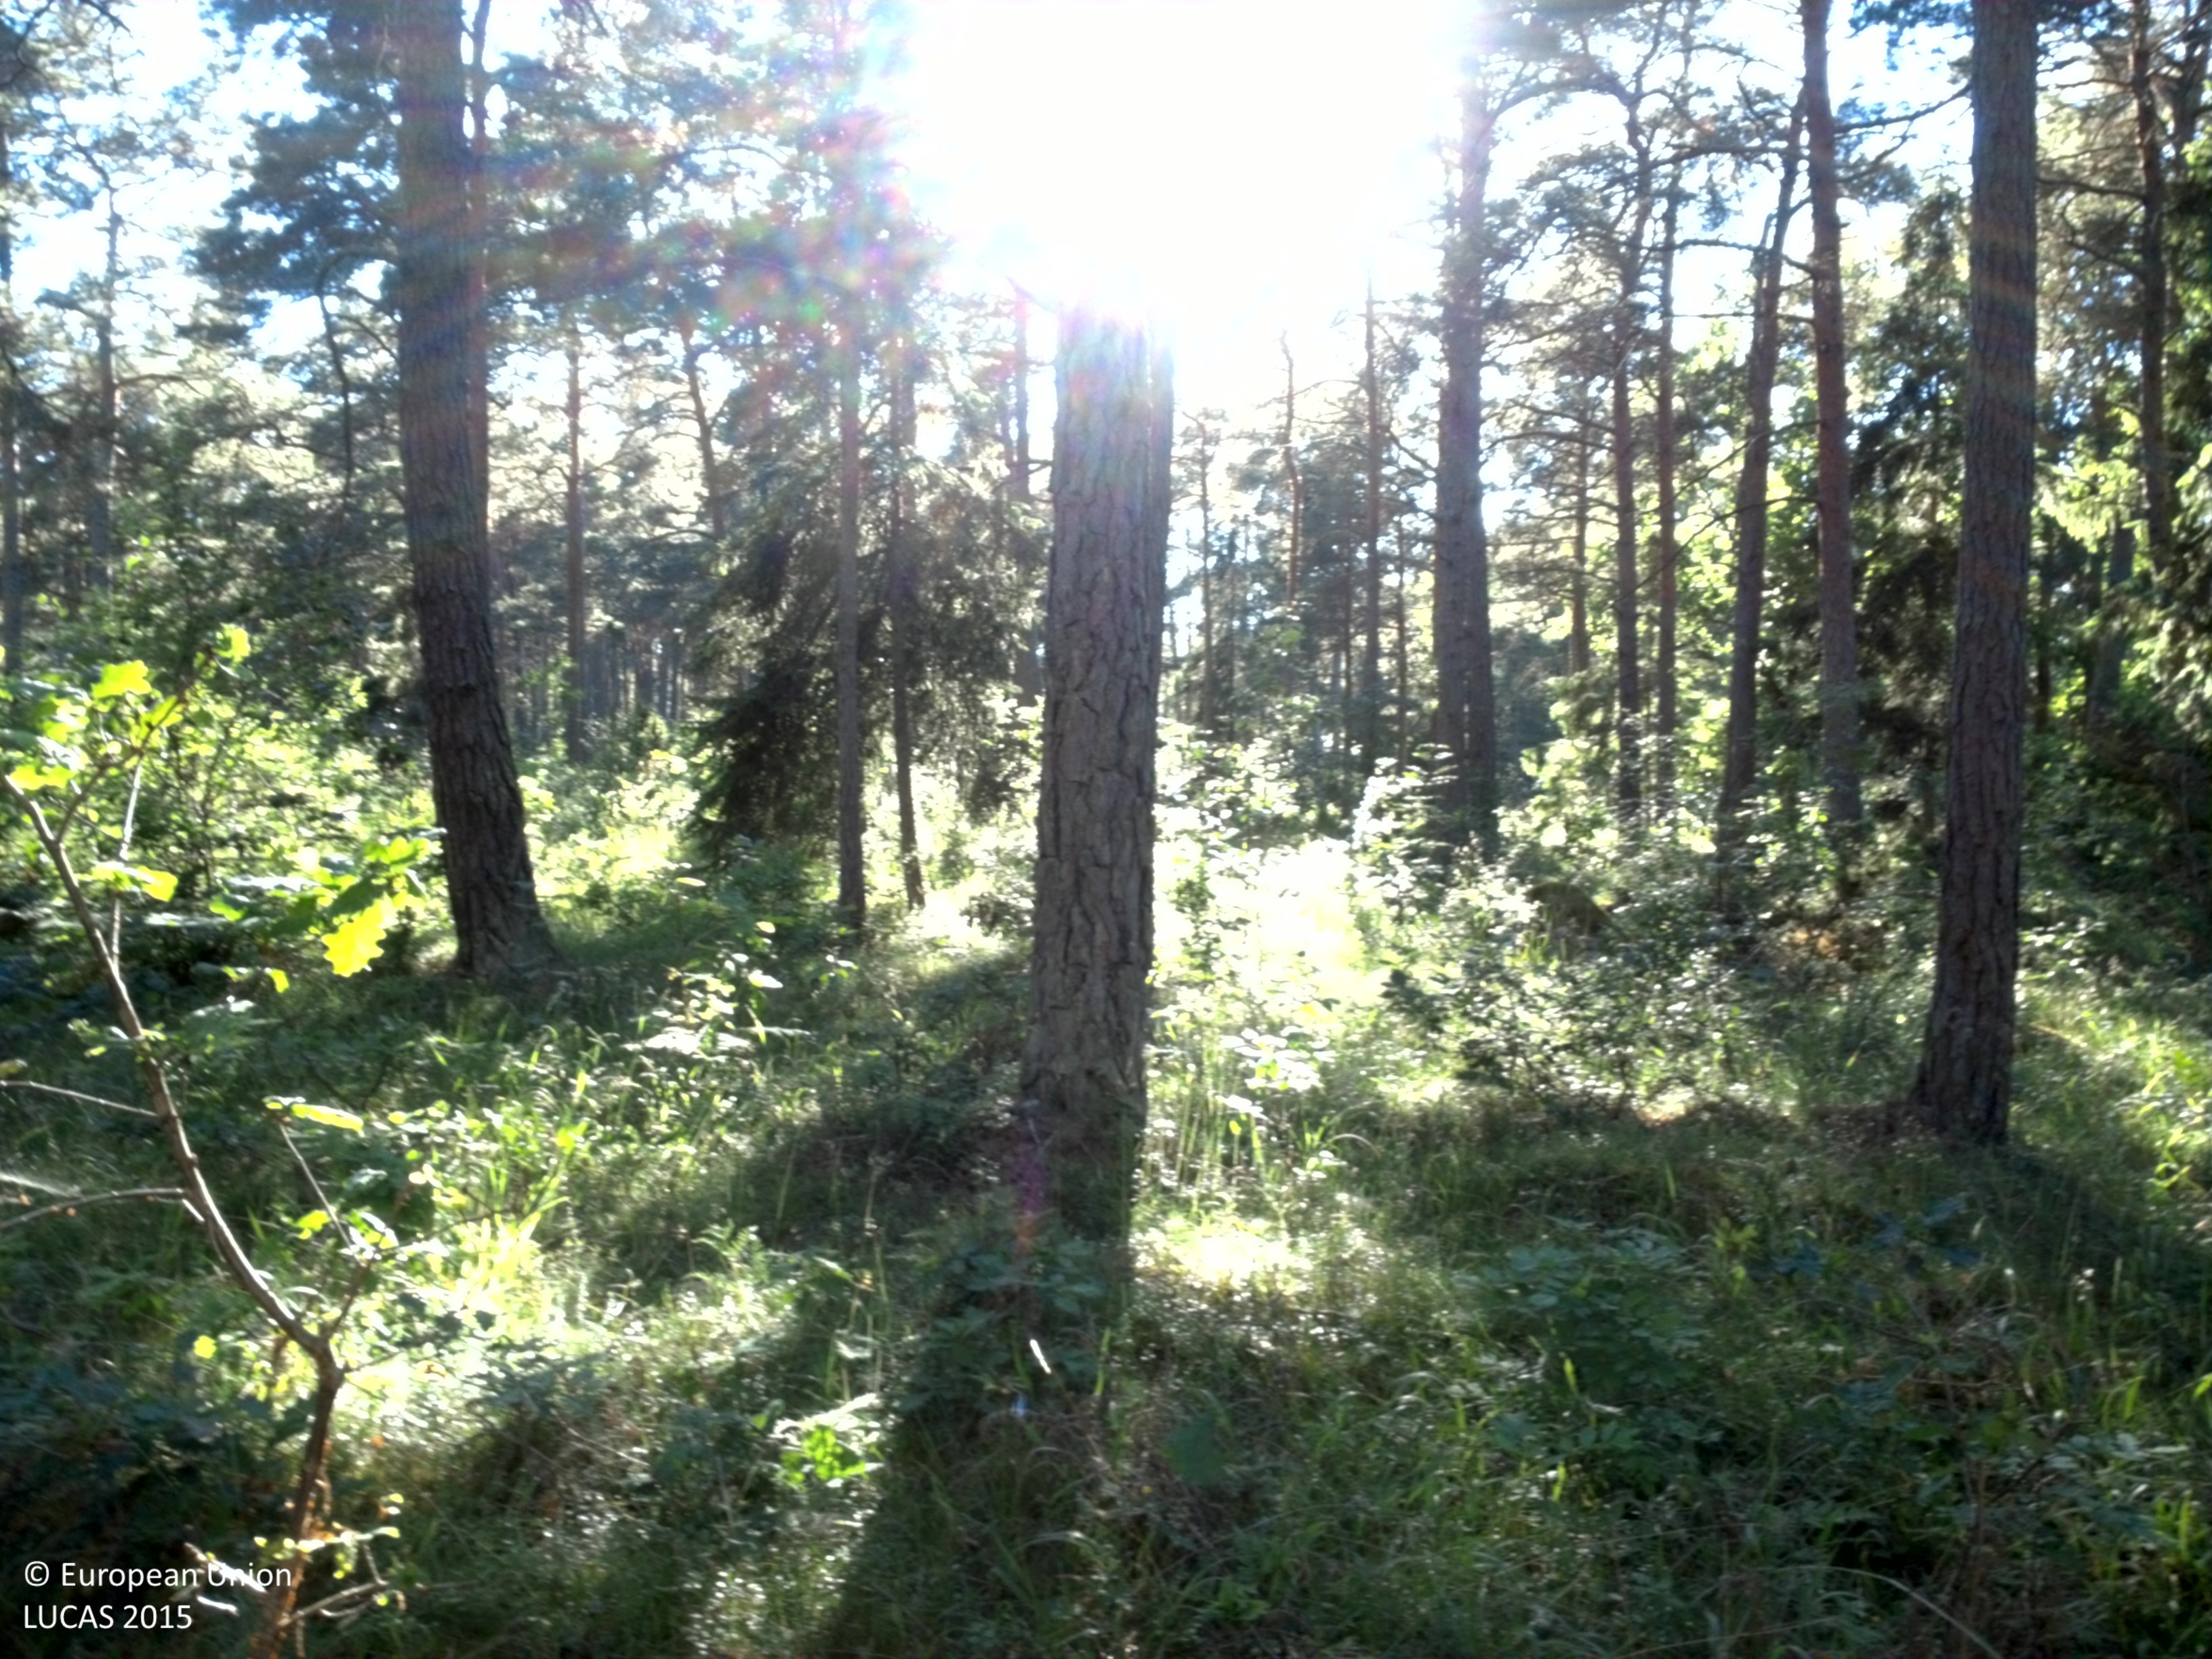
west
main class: Woodland
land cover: Pine dominated coniferous woodland
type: hemiboreal forest and nemoral coniferous forest and mixed broadleaved-coniferous forest
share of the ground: > 75 %
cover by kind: coniferous forest trees 80 %, herbaceous plants 15 %, broadleaved forest trees 5 %
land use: Forestry
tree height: > 5 m
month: July
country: SE
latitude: 57.8006
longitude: 18.5723
